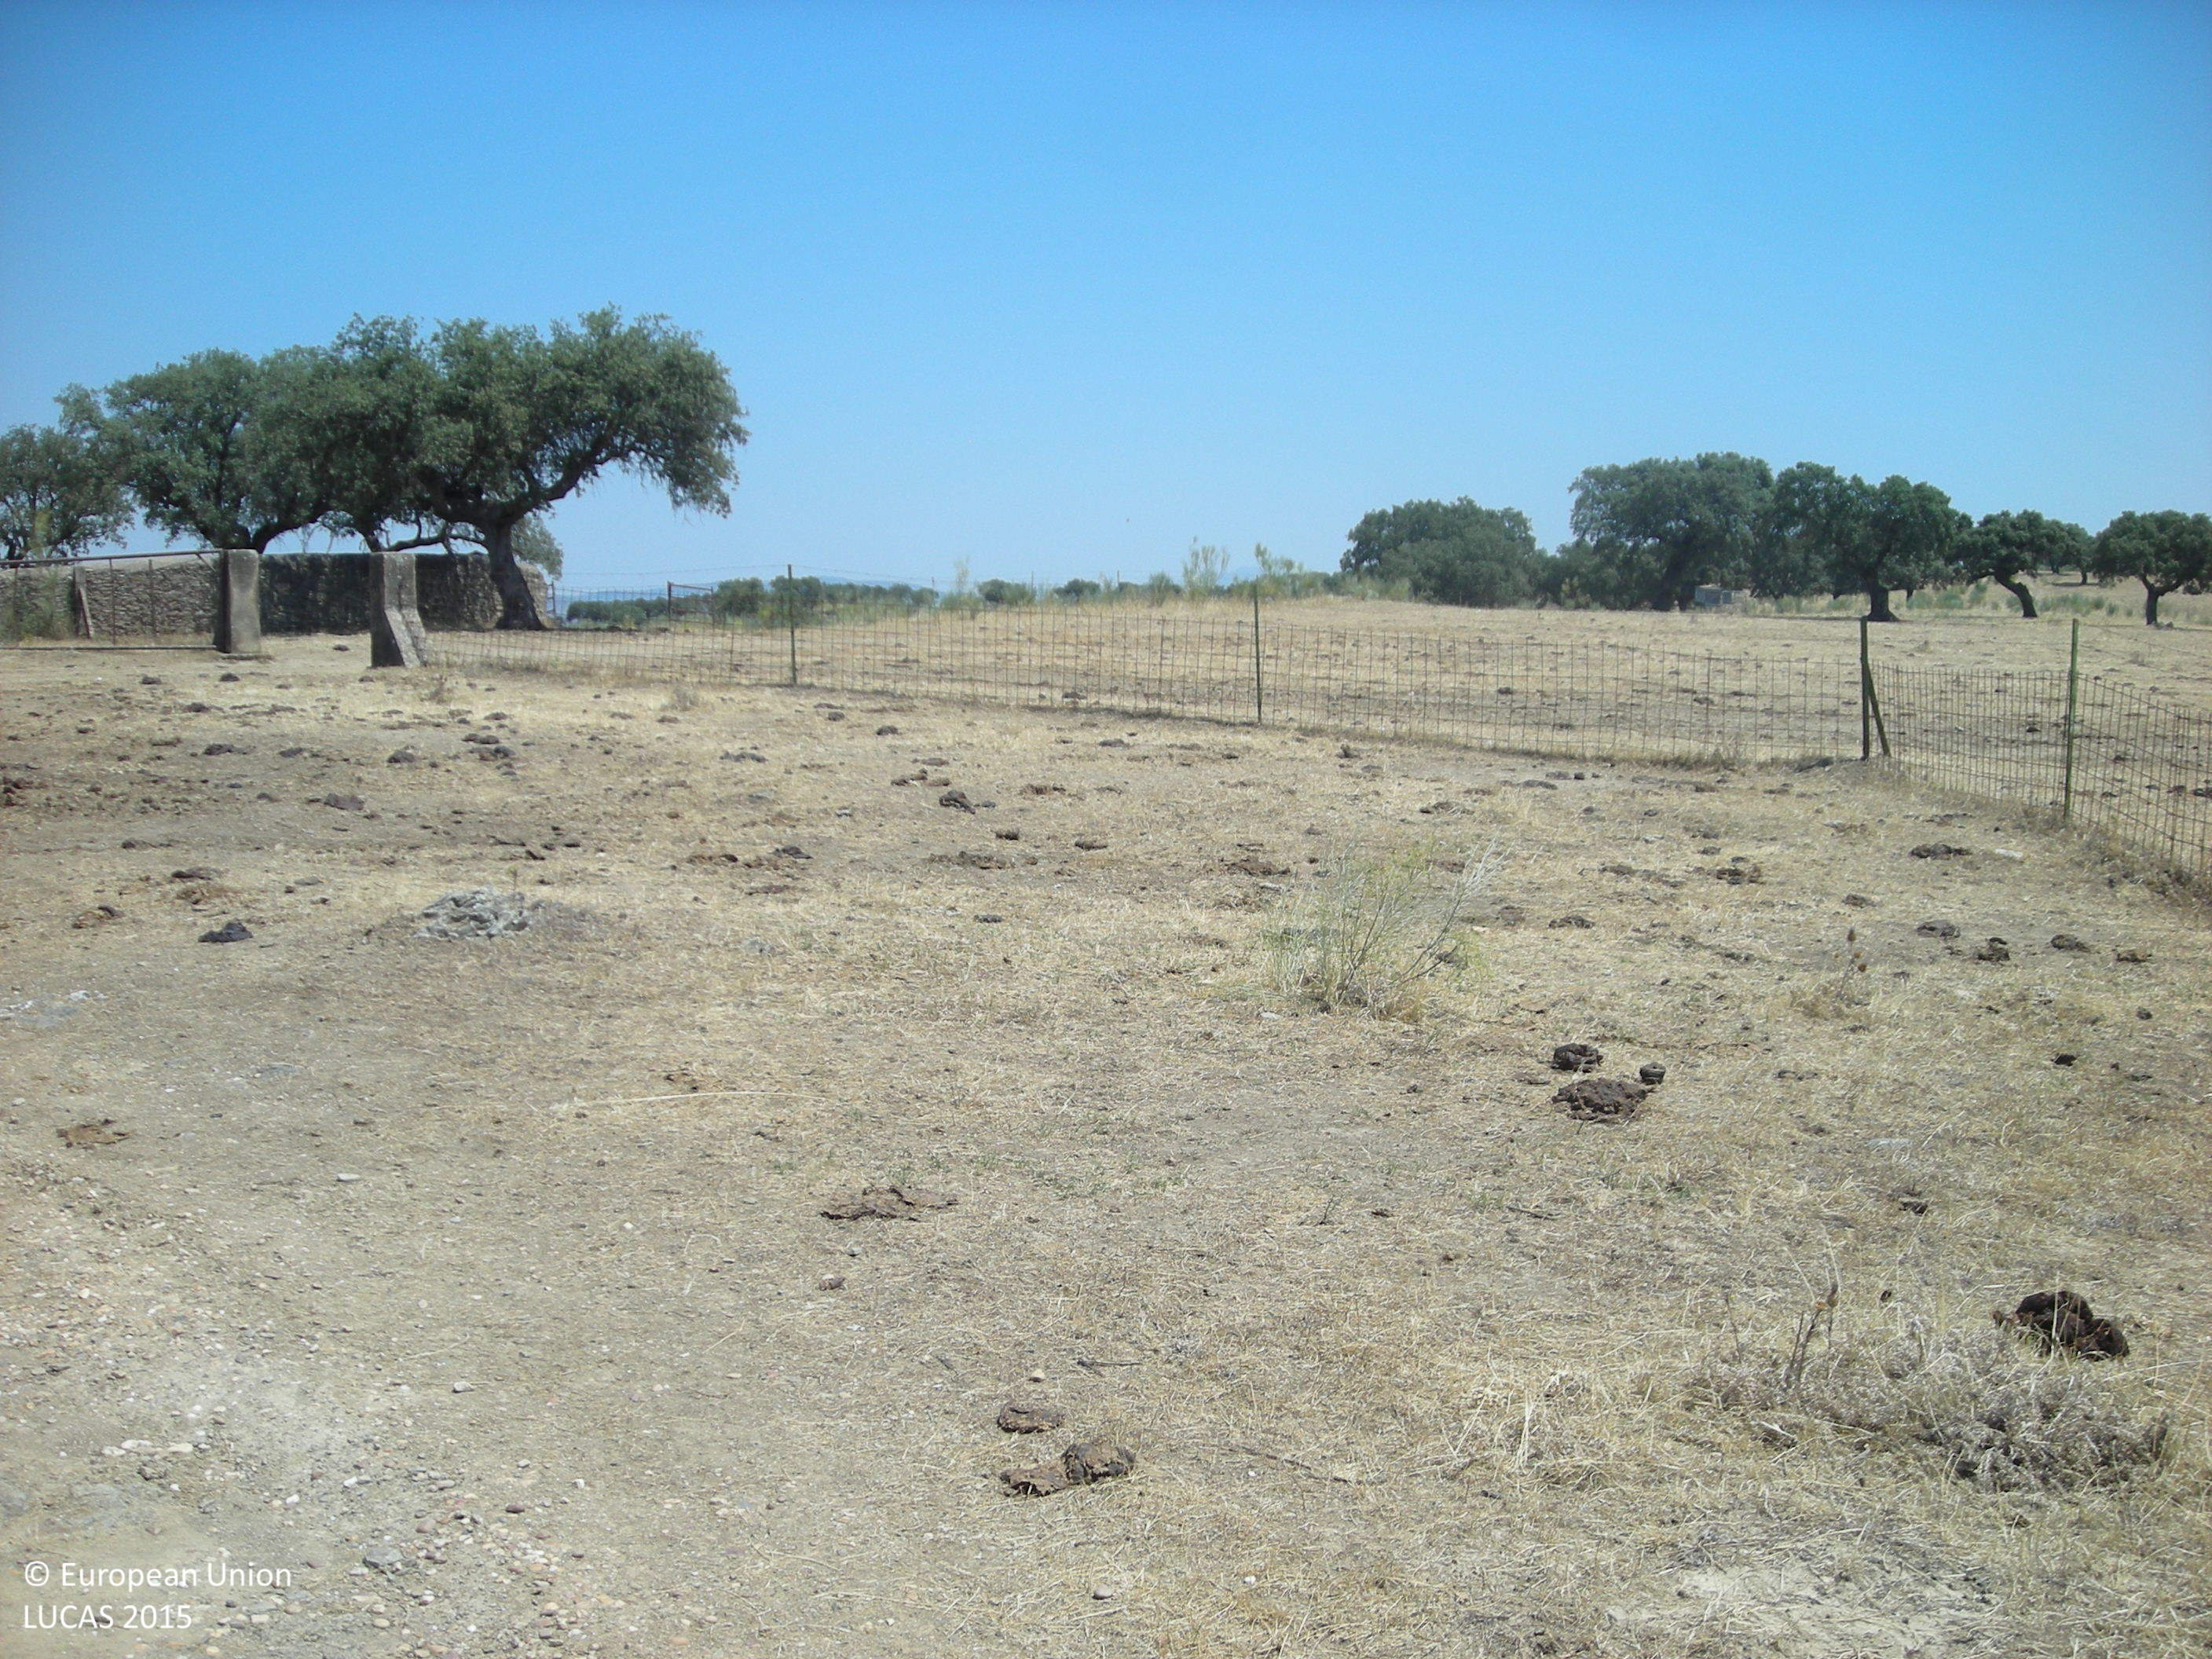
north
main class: Woodland
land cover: Broadleaved woodland
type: broadleaved evergreen forest
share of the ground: 25 - 50 %
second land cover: Grassland without tree/shrub cover
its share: 50 - 75 %
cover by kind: shrubs 60 %, broadleaved forest trees 40 %
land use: Forestry
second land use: Agriculture (excluding fallow land and kitchen gardens)
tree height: > 5 m
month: June
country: ES
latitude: 39.2451
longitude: -5.5164
